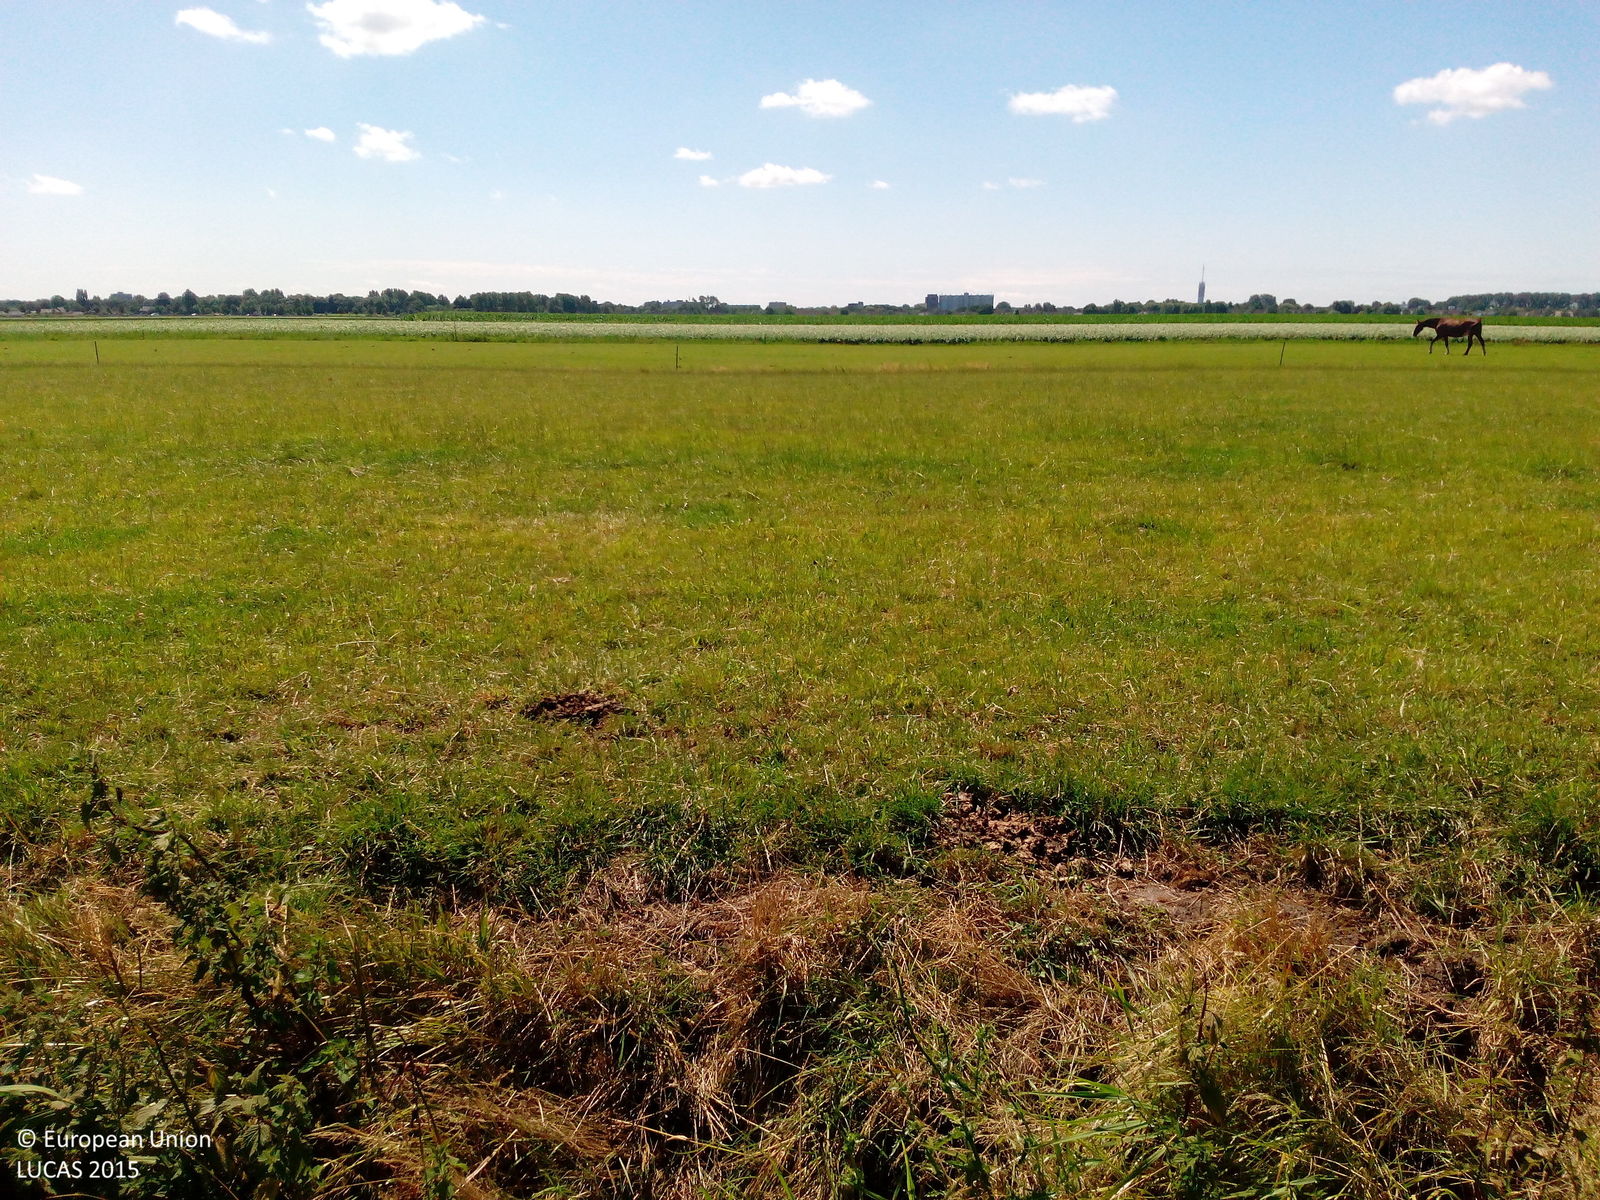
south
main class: Grassland
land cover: Grassland without tree/shrub cover
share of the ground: > 75 %
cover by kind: herbaceous plants 100 %
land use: Agriculture (excluding fallow land and kitchen gardens)
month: July
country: NL
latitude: 52.1673
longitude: 4.6599
